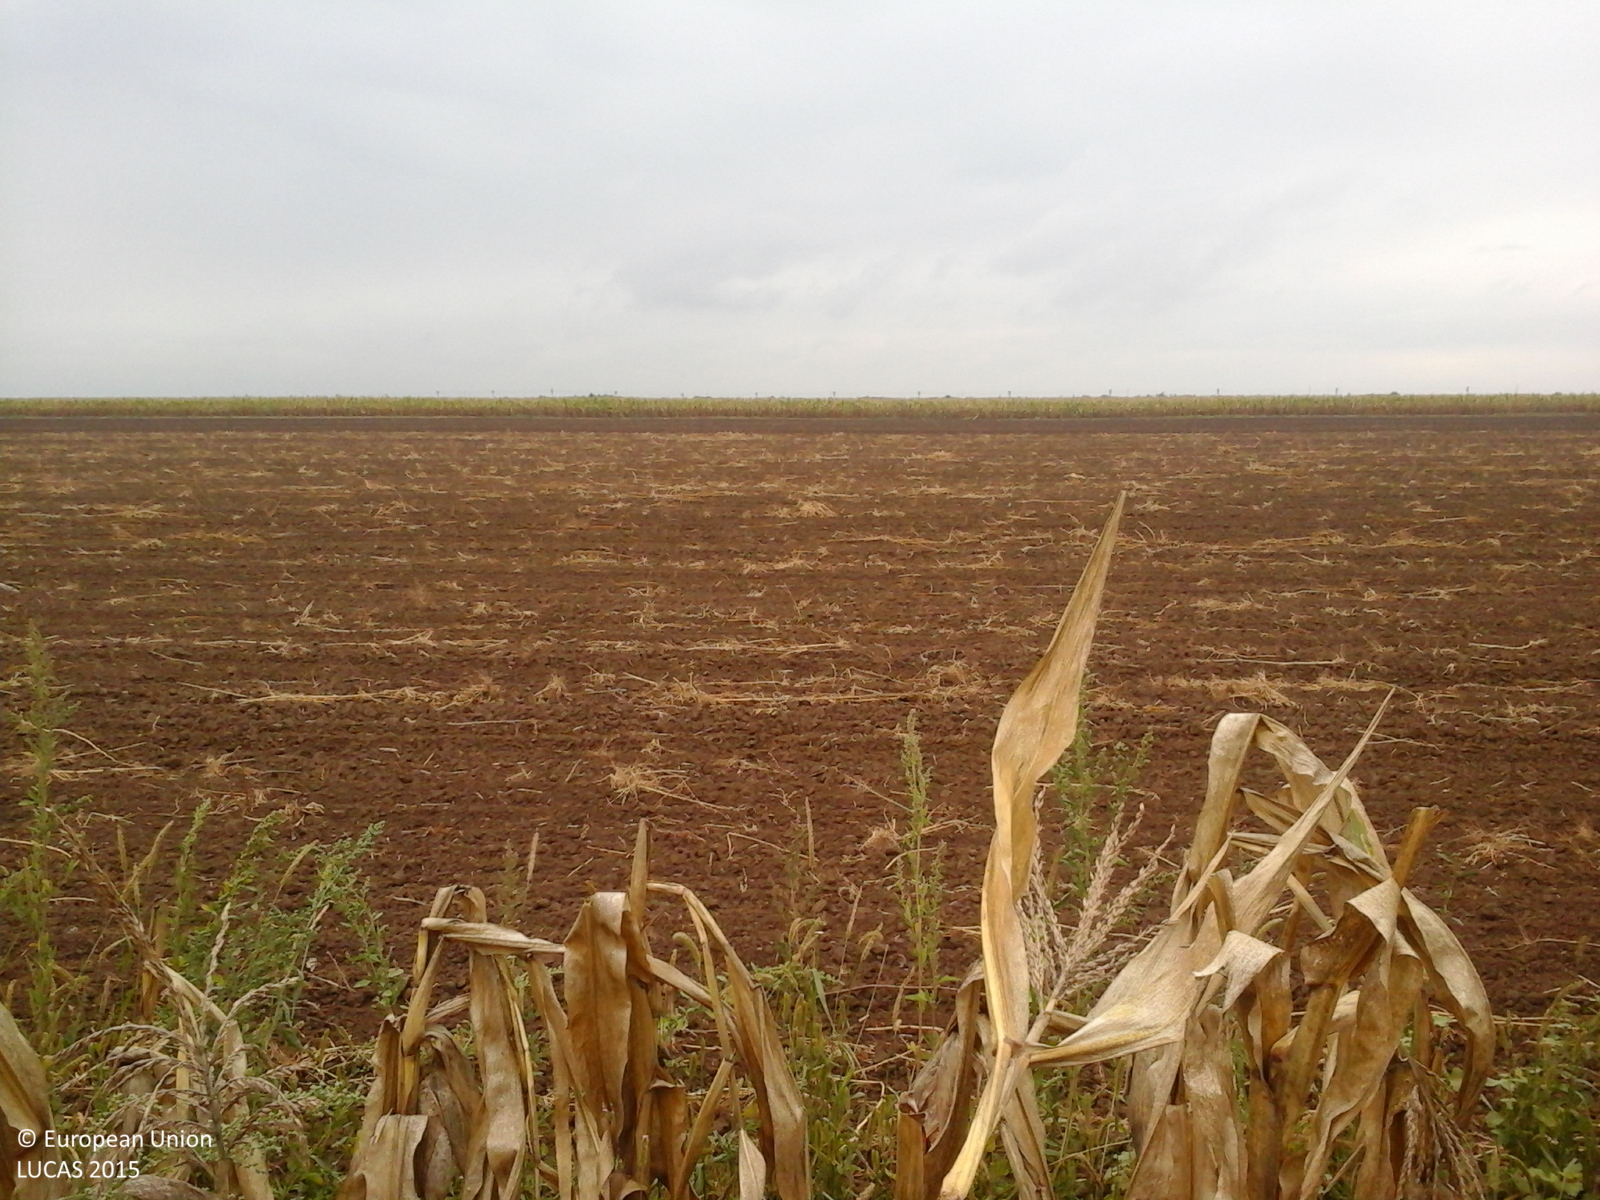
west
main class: Cropland
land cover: Maize
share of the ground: > 75 %
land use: Agriculture (excluding fallow land and kitchen gardens)
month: September
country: RO
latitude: 47.0007
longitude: 21.8416
